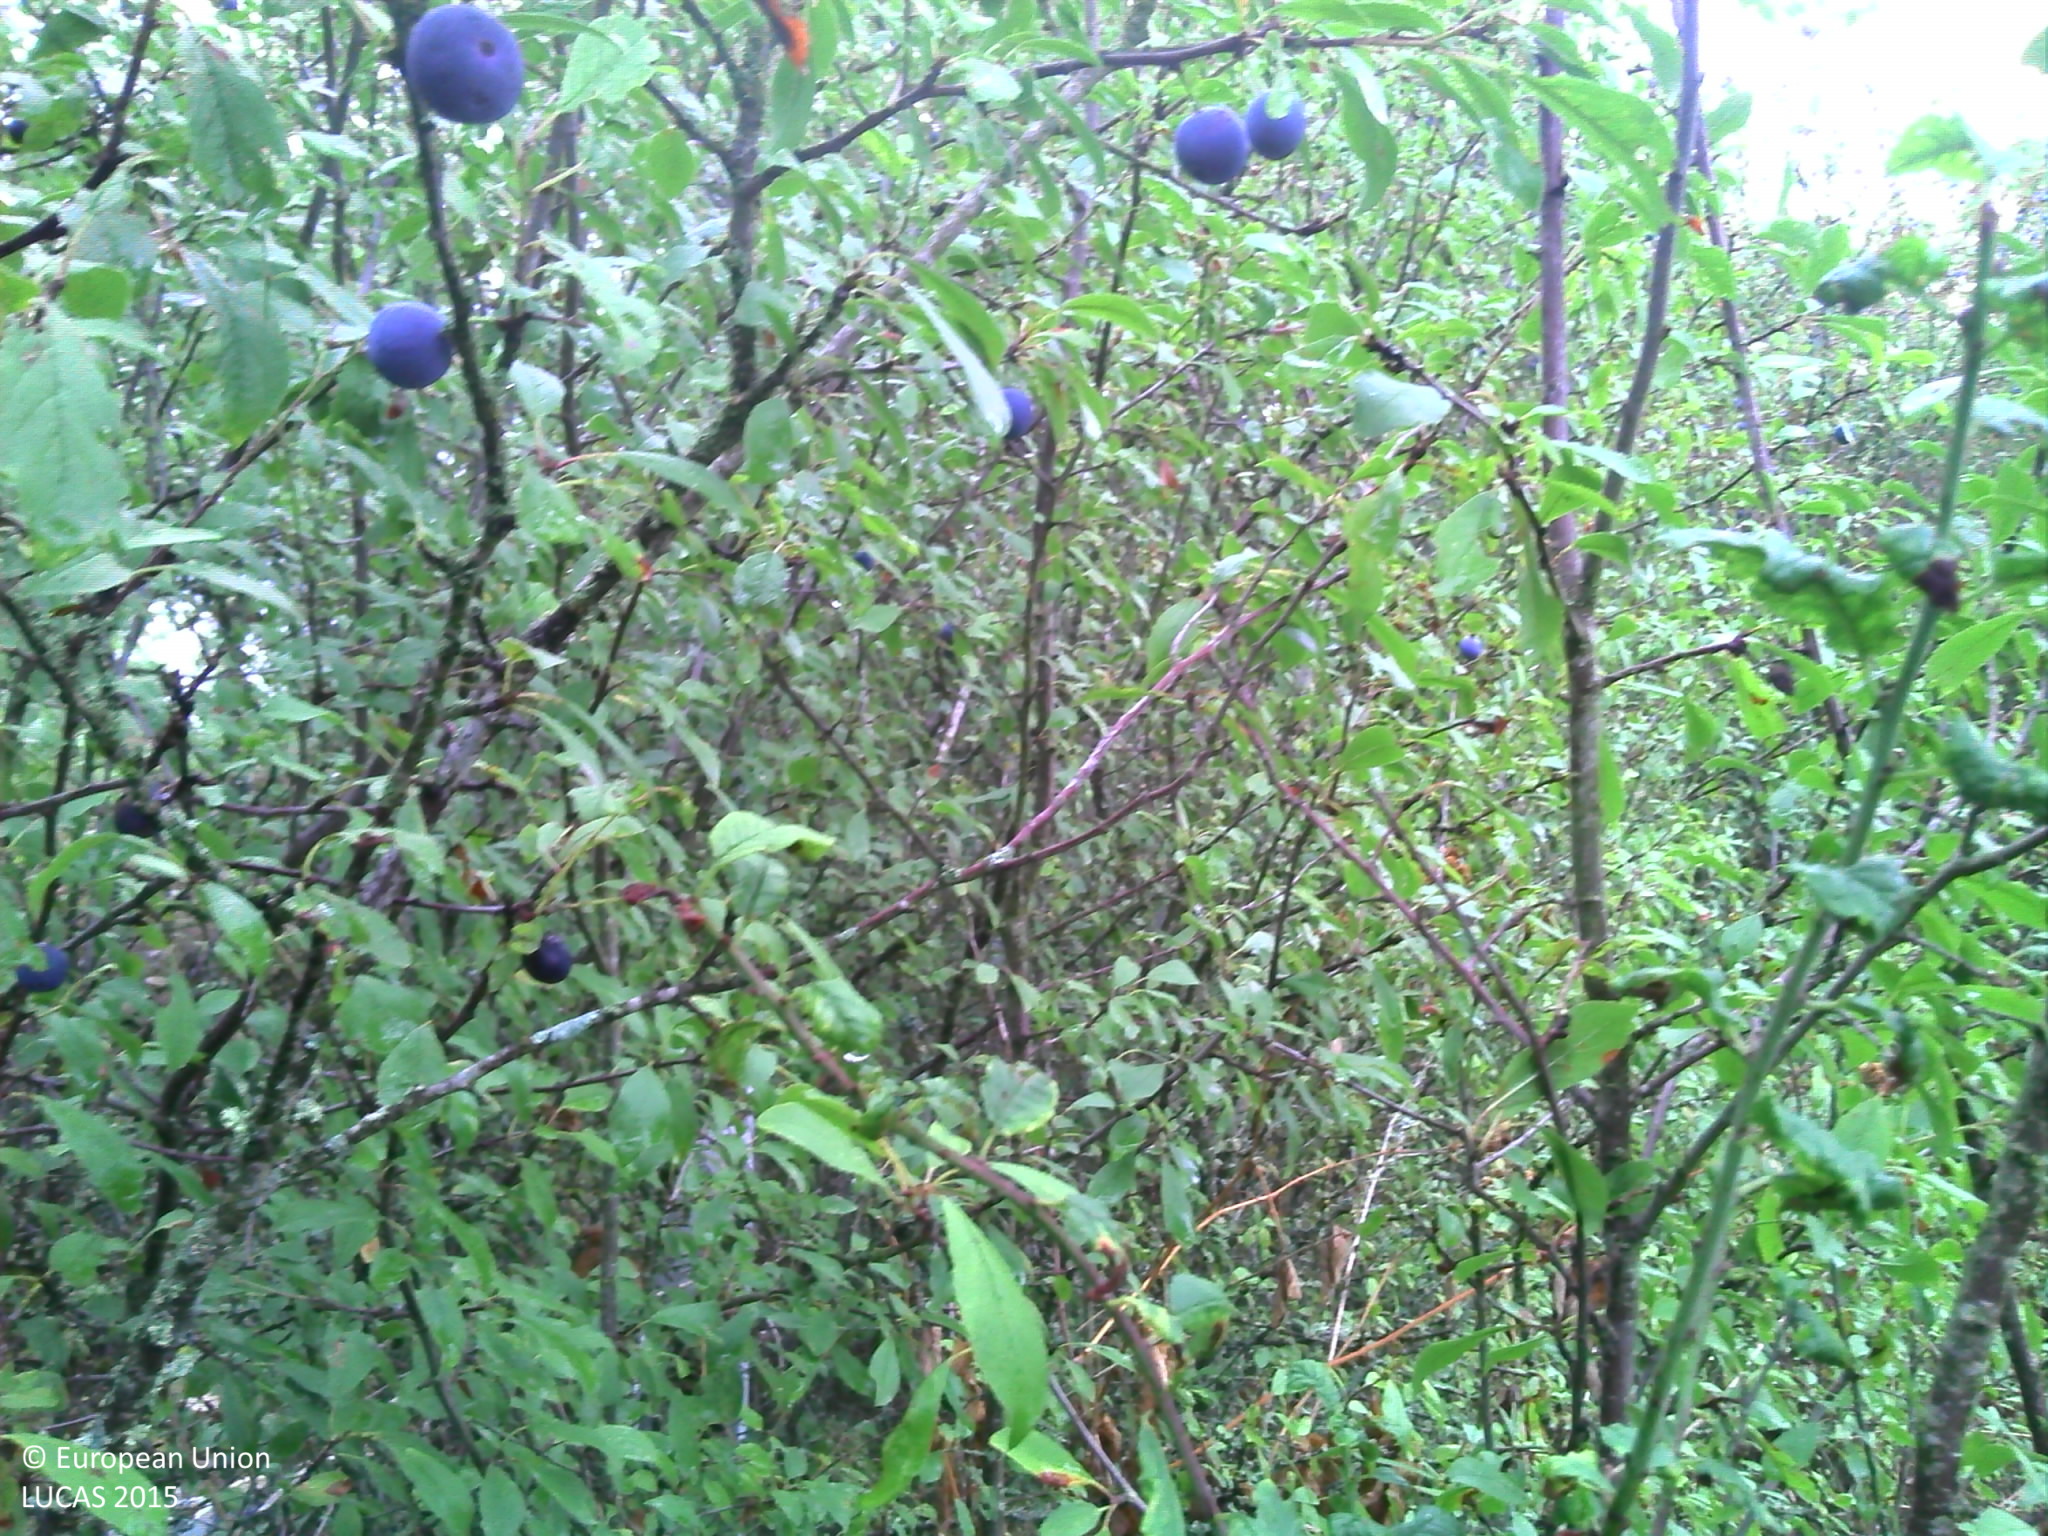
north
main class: Woodland
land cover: Broadleaved woodland
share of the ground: > 75 %
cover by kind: broadleaved forest trees 100 %
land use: Semi-natural and natural areas not in use
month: August
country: FR
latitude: 47.4151
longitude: 4.7911
